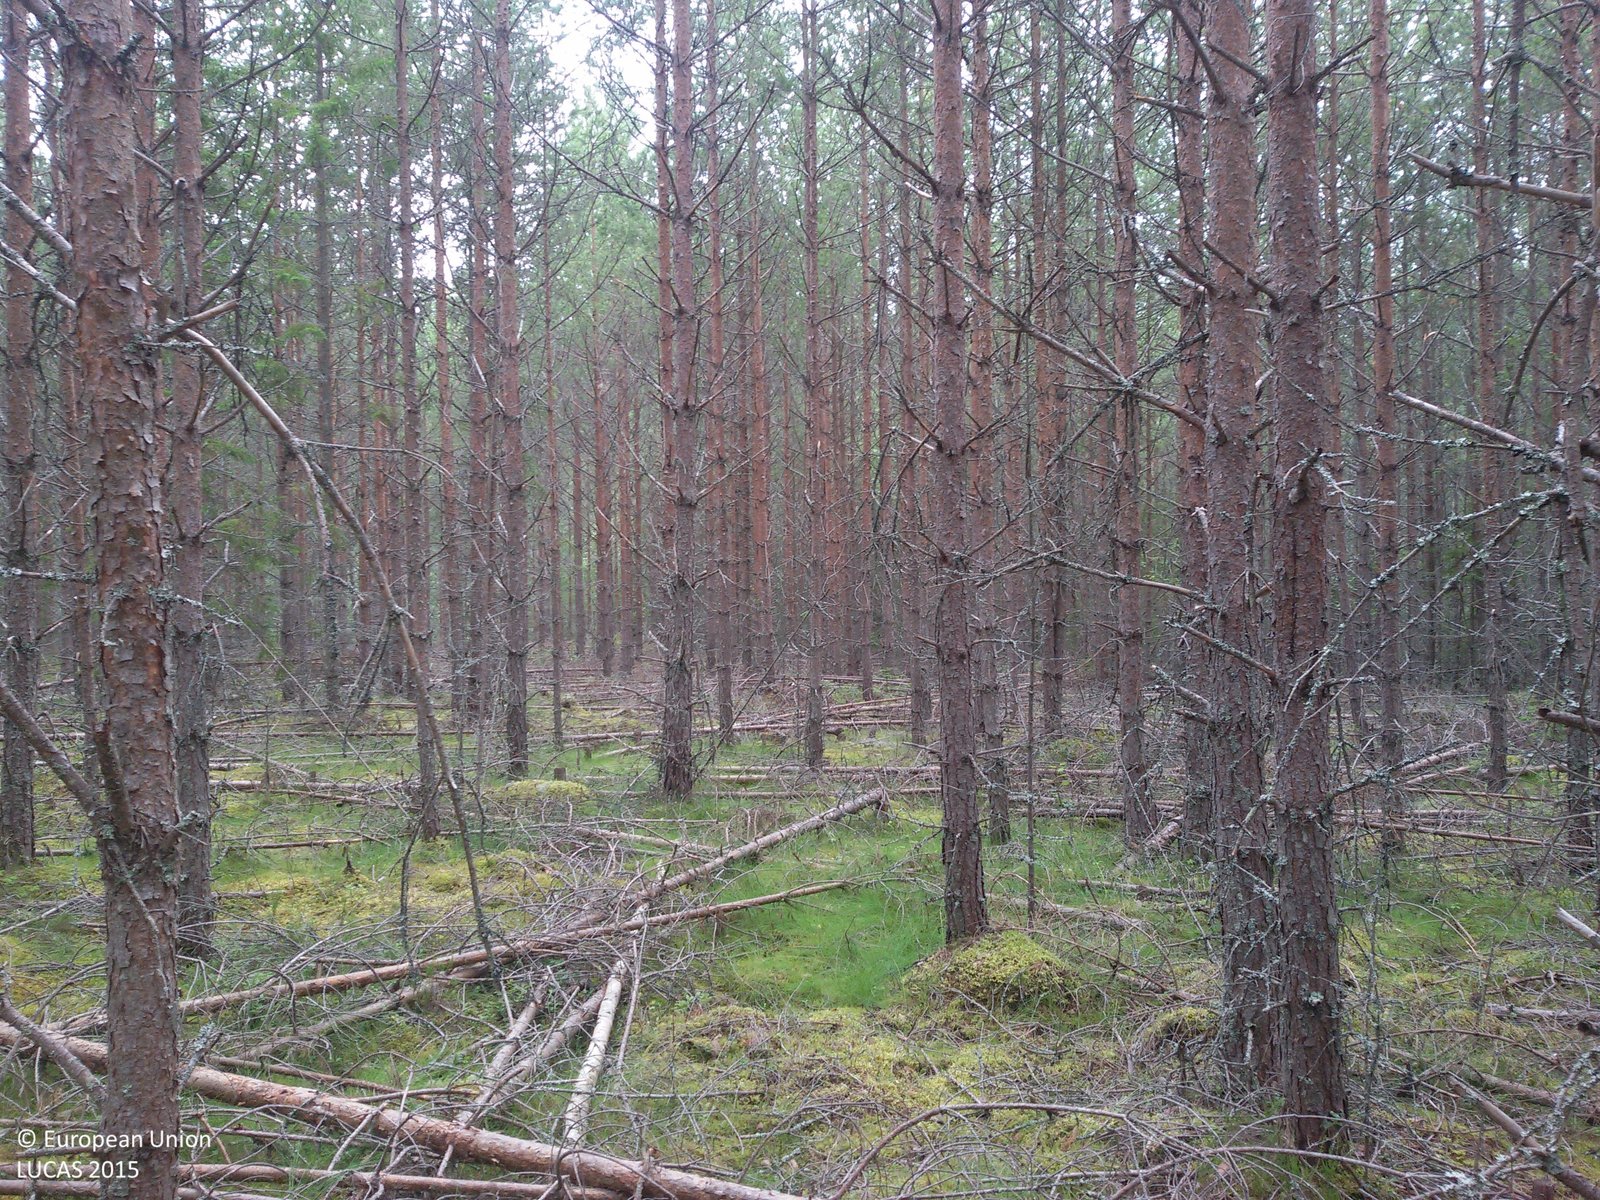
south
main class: Woodland
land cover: Pine dominated coniferous woodland
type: boreal forest
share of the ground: > 75 %
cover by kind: coniferous forest trees 80 %, shrubs 20 %
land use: Forestry
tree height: > 5 m
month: July
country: SE
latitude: 60.5085
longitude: 15.9062
